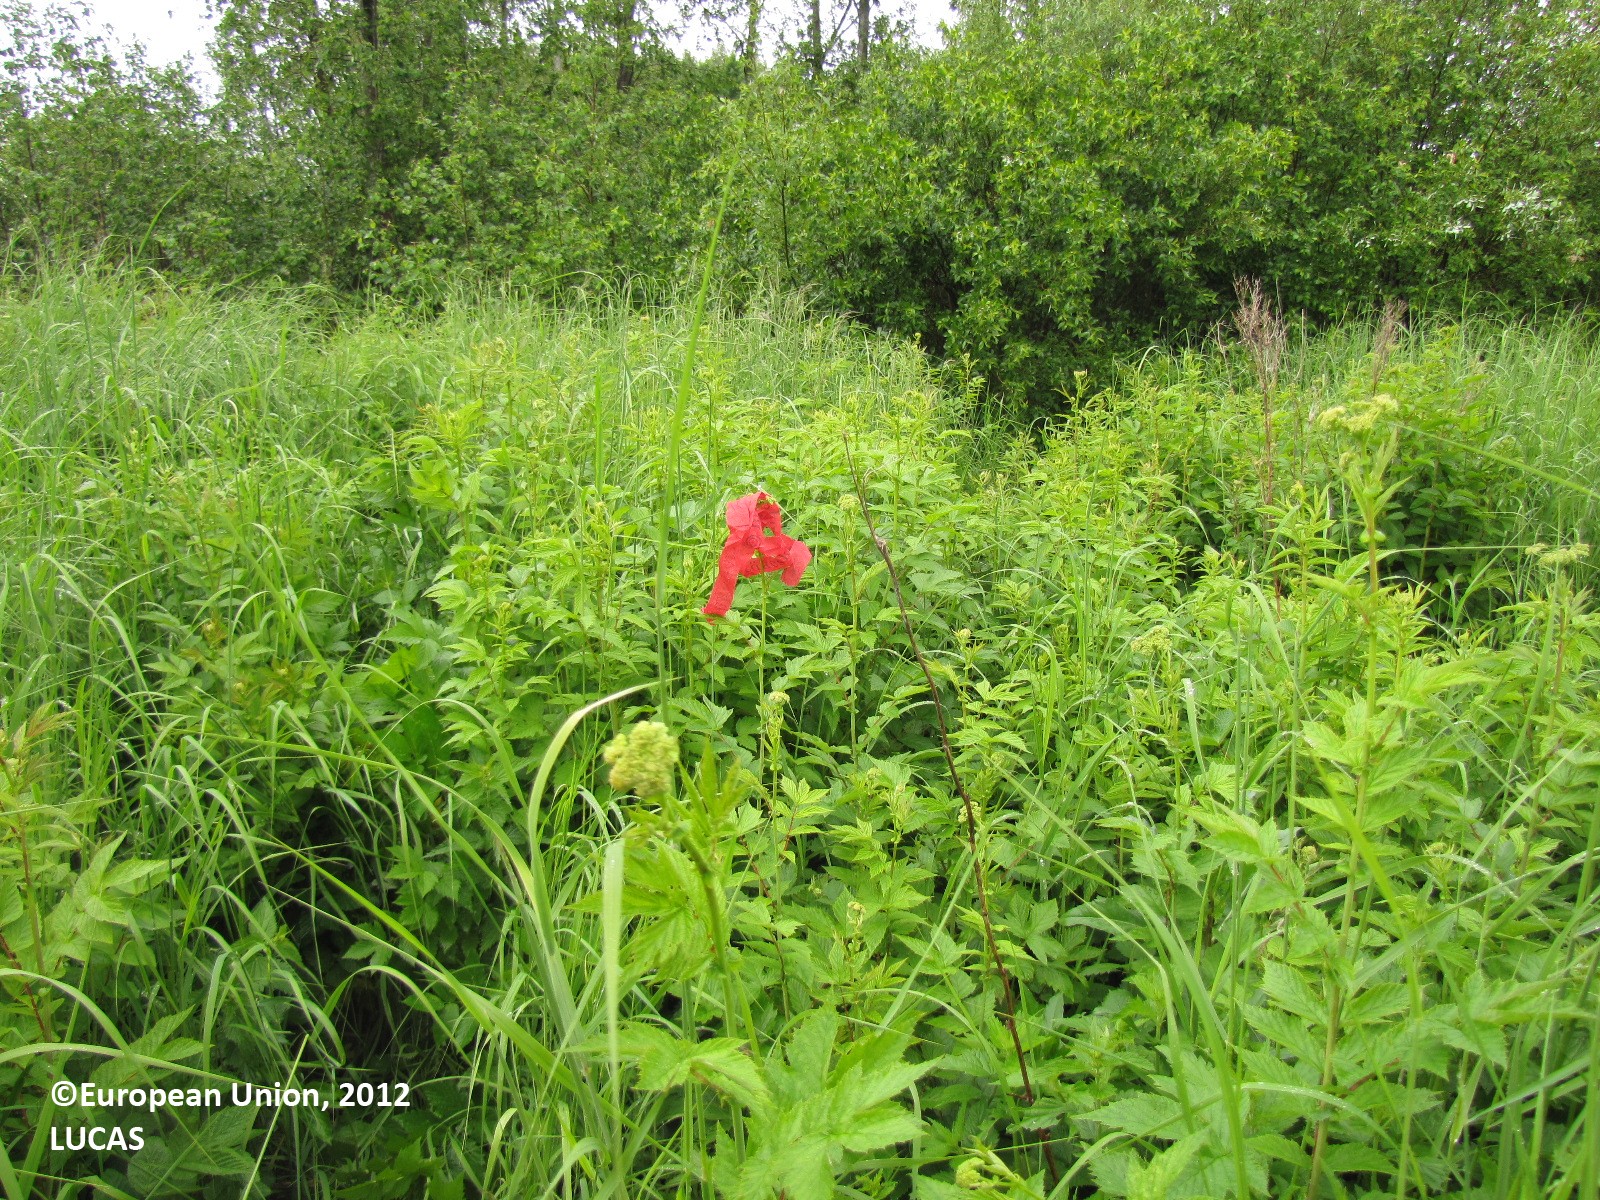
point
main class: Shrubland
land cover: Shrubland with sparse tree cover
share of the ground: 25 - 50 %
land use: Agriculture (excluding fallow land and kitchen gardens)
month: June
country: FI
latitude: 61.2964
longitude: 24.3382
